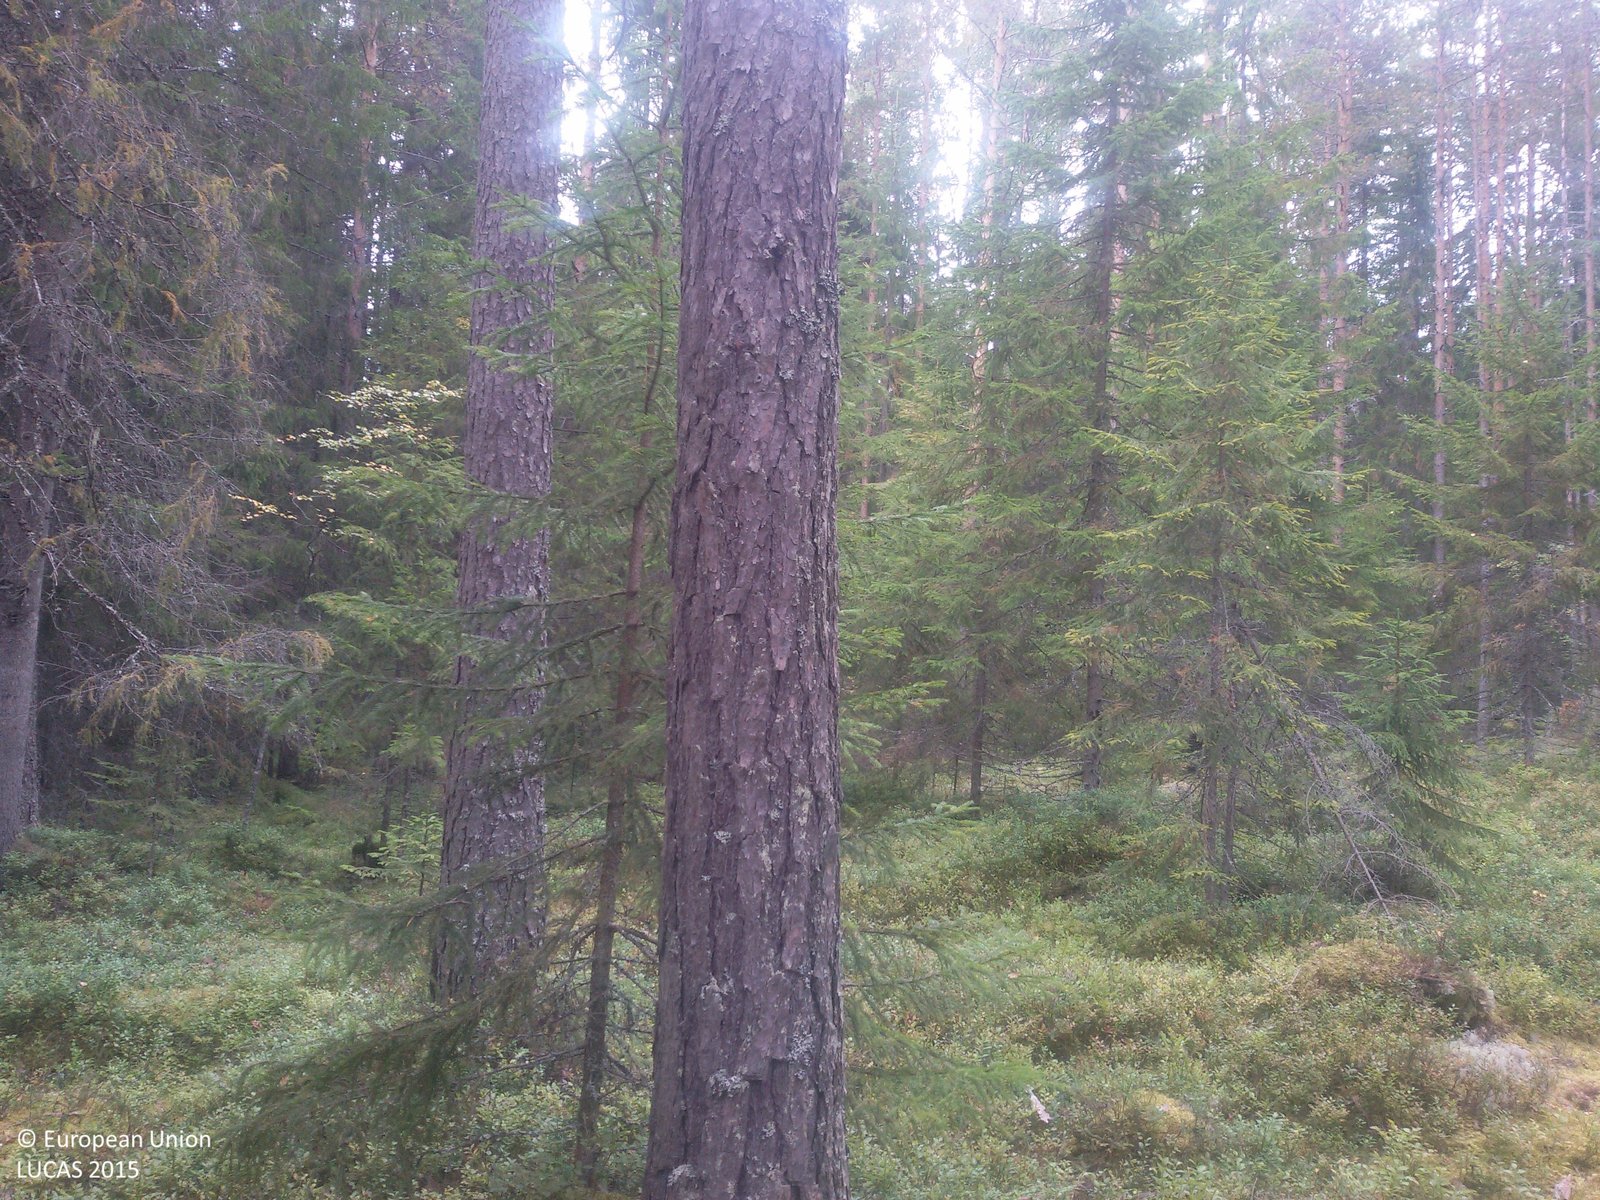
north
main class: Woodland
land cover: Pine dominated coniferous woodland
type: boreal forest
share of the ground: 50 - 75 %
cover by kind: coniferous forest trees 70 %, herbaceous plants 15 %, lichens and mosses 15 %
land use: Forestry
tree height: > 5 m
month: September
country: SE
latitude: 61.0496
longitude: 14.9678
